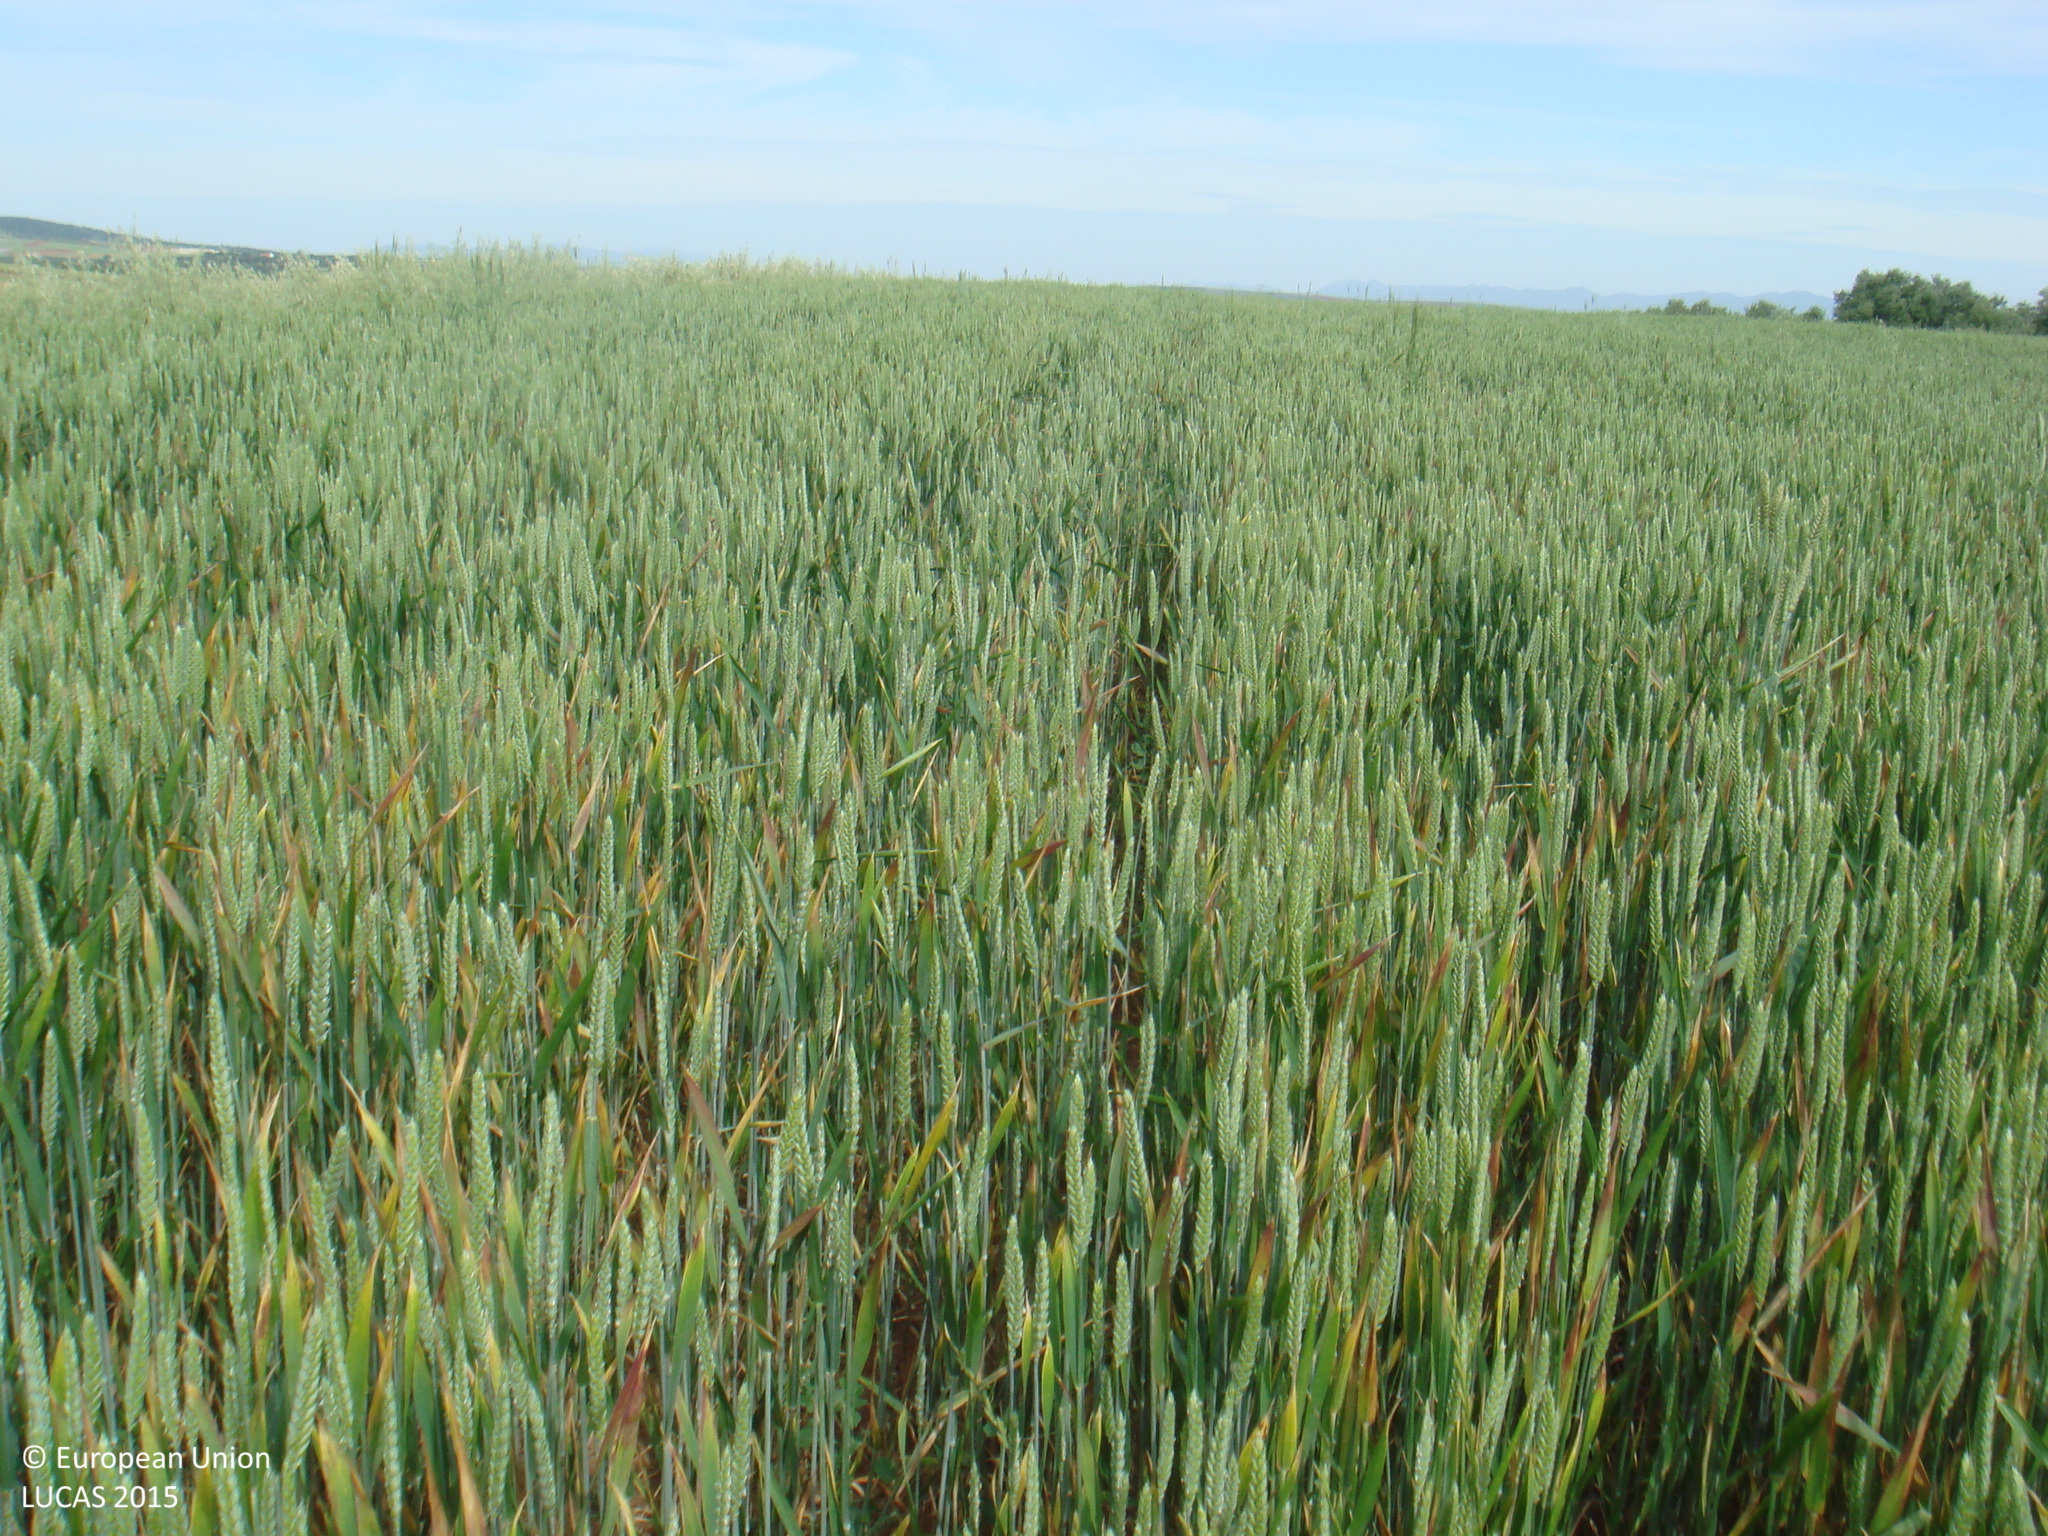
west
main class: Cropland
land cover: Common wheat
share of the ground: > 75 %
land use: Agriculture (excluding fallow land and kitchen gardens)
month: May
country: ES
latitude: 38.4591
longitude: -5.1447
